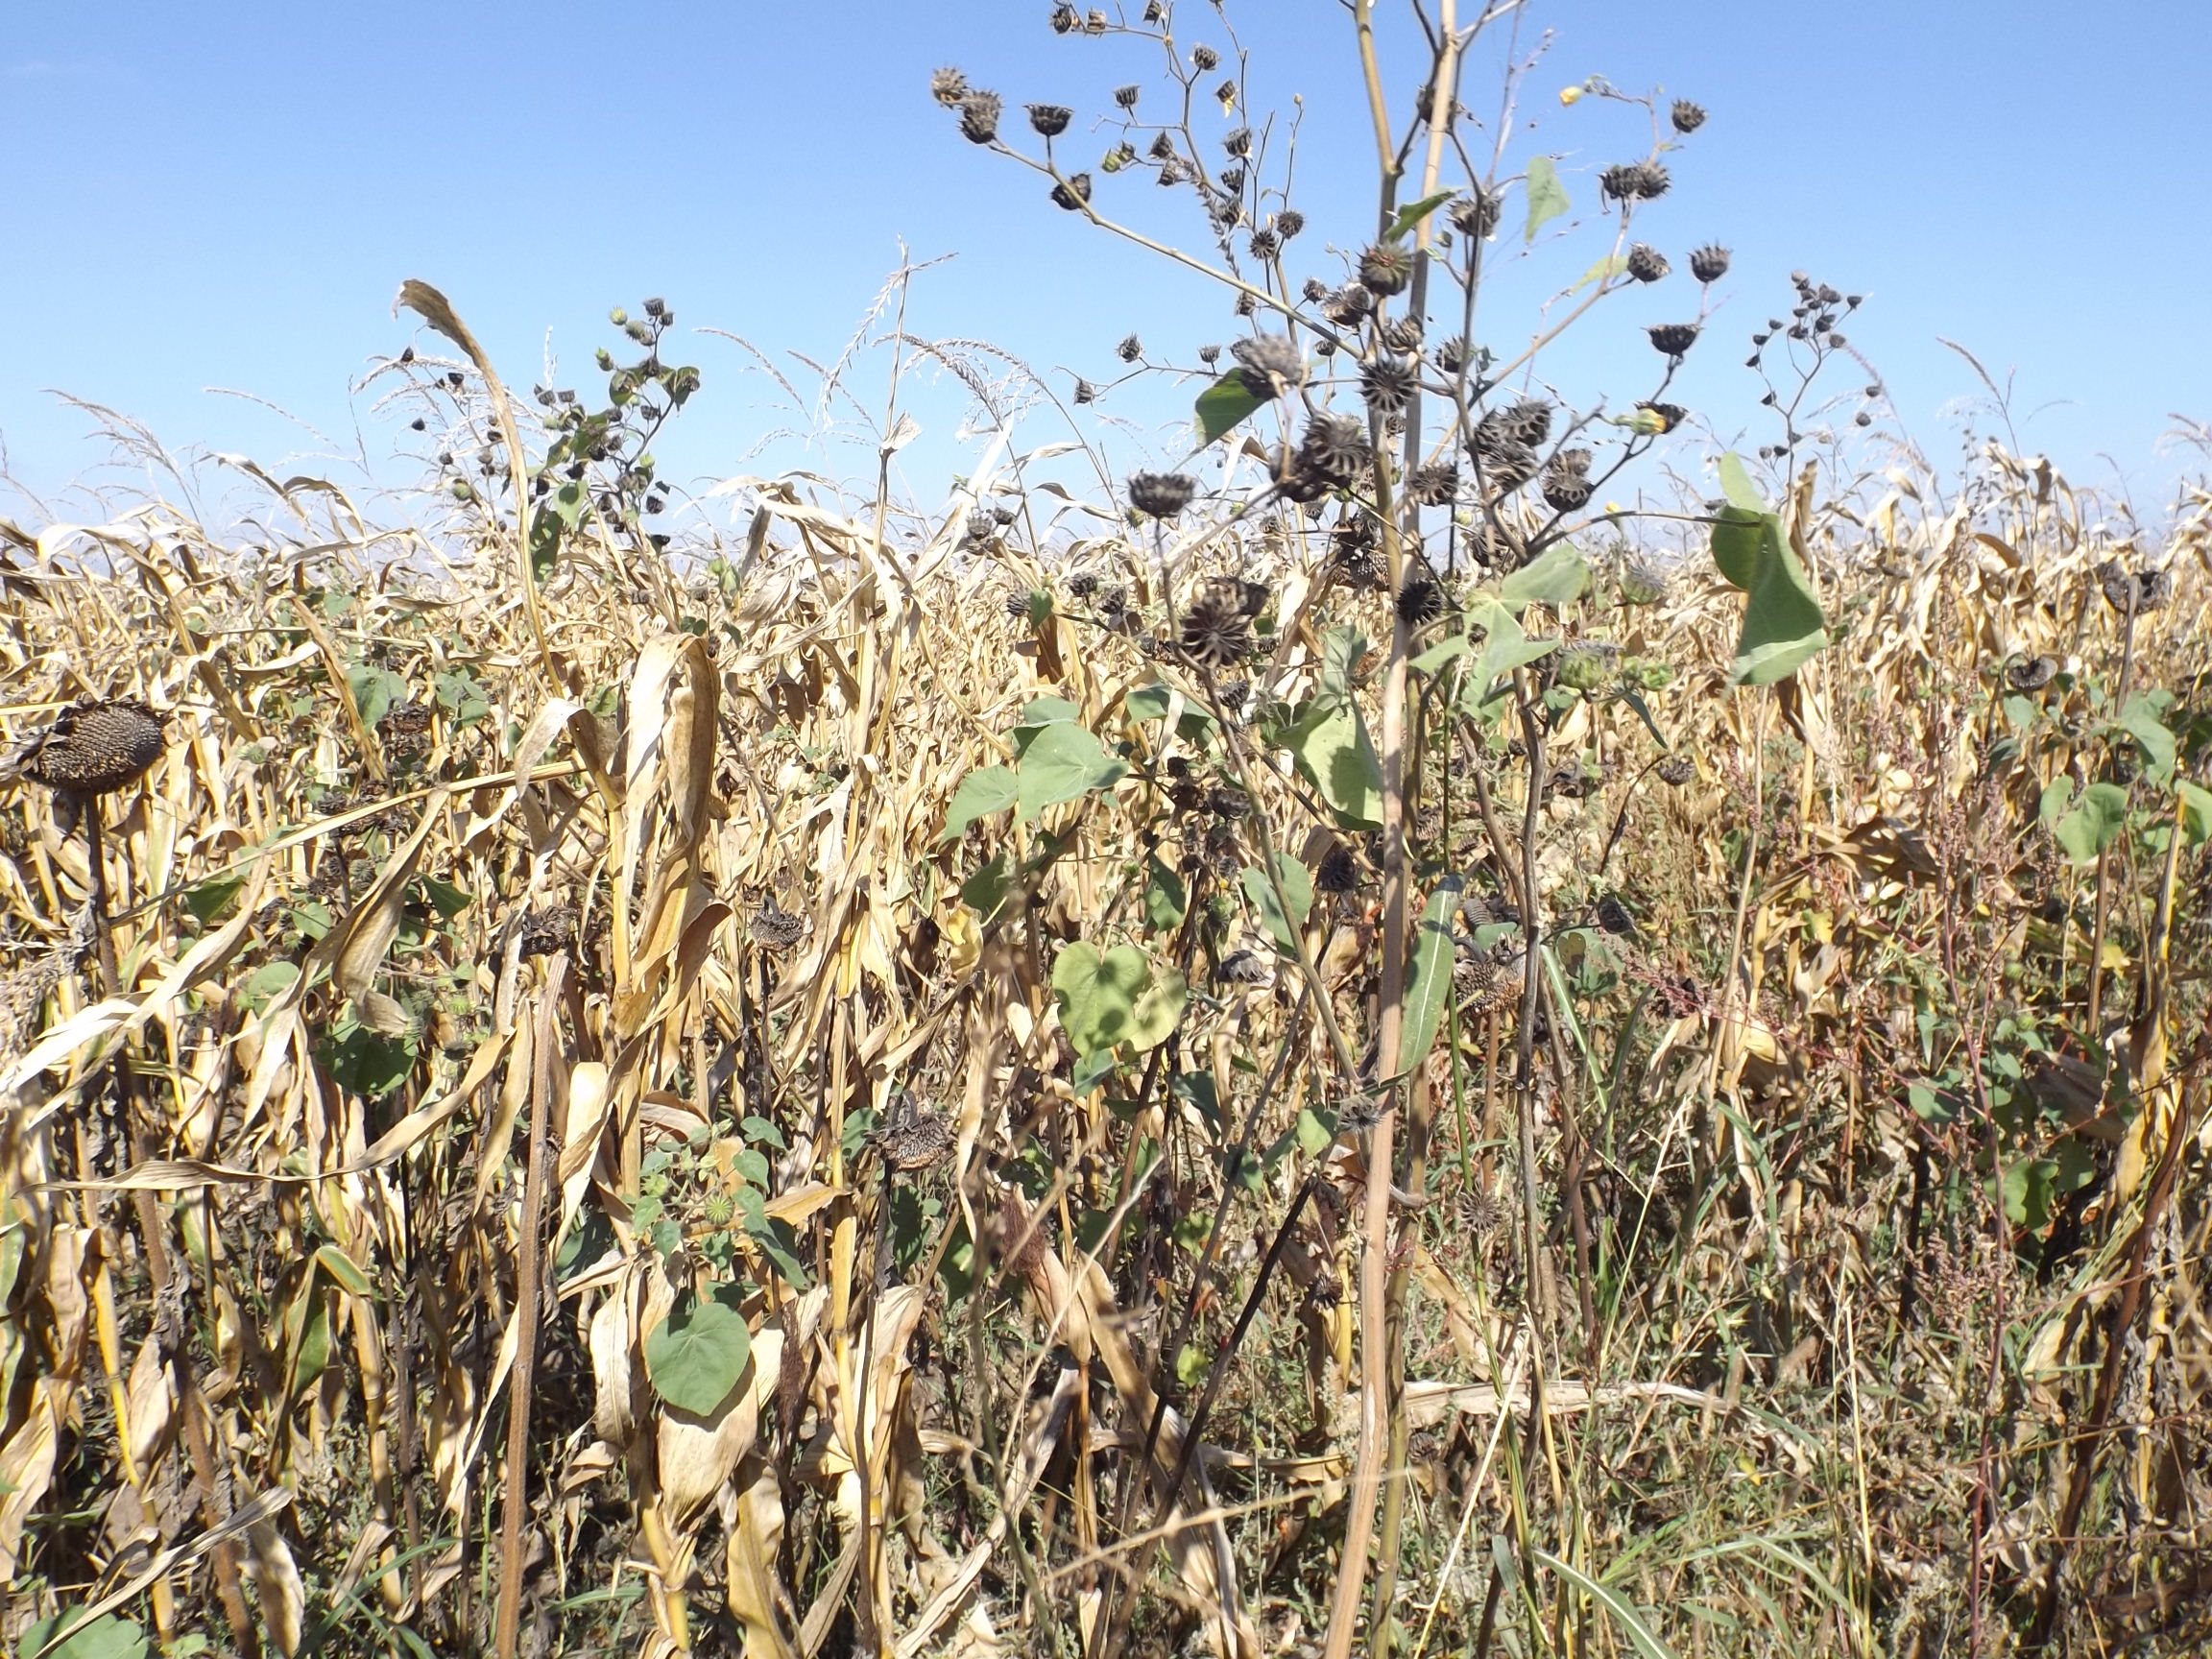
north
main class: Cropland
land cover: Maize
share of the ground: > 75 %
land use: Agriculture (excluding fallow land and kitchen gardens)
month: September
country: BG
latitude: 43.9389
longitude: 26.4918
